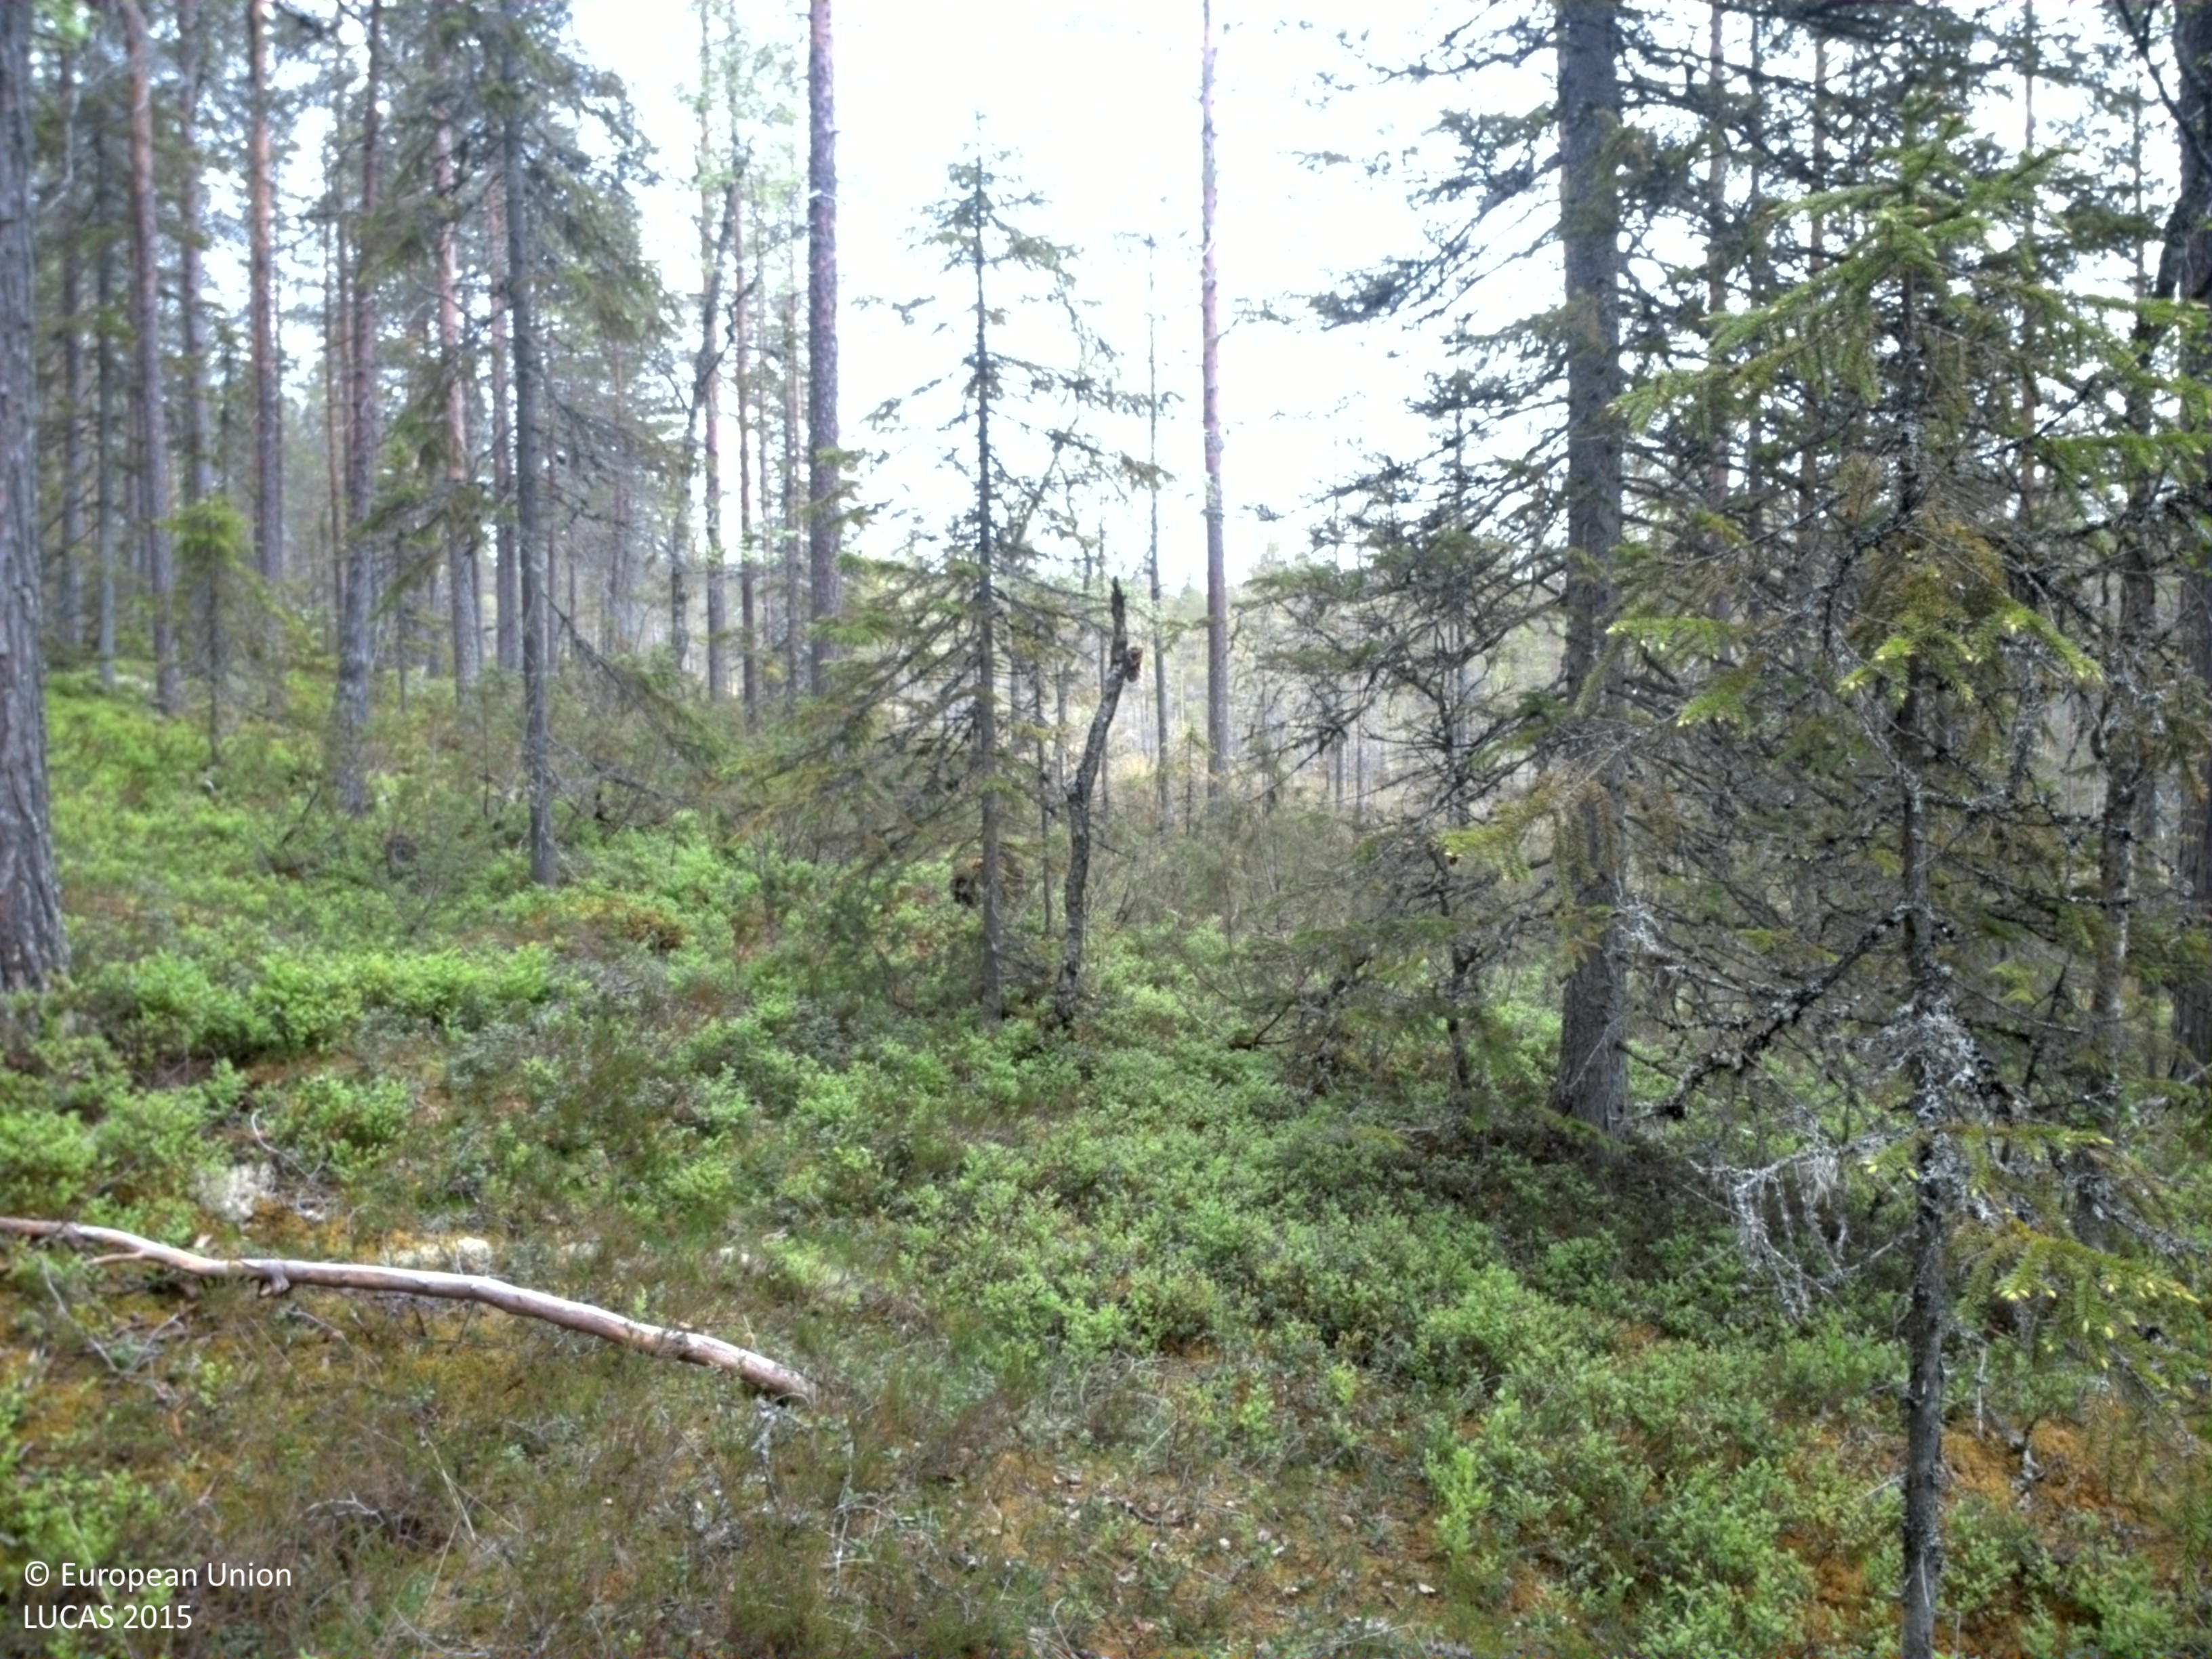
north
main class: Woodland
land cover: Other coniferous woodland
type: boreal forest
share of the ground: 50 - 75 %
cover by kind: coniferous forest trees 65 %, lichens and mosses 25 %, herbaceous plants 10 %
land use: Forestry
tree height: > 5 m
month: July
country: SE
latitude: 61.4326
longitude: 13.6052
